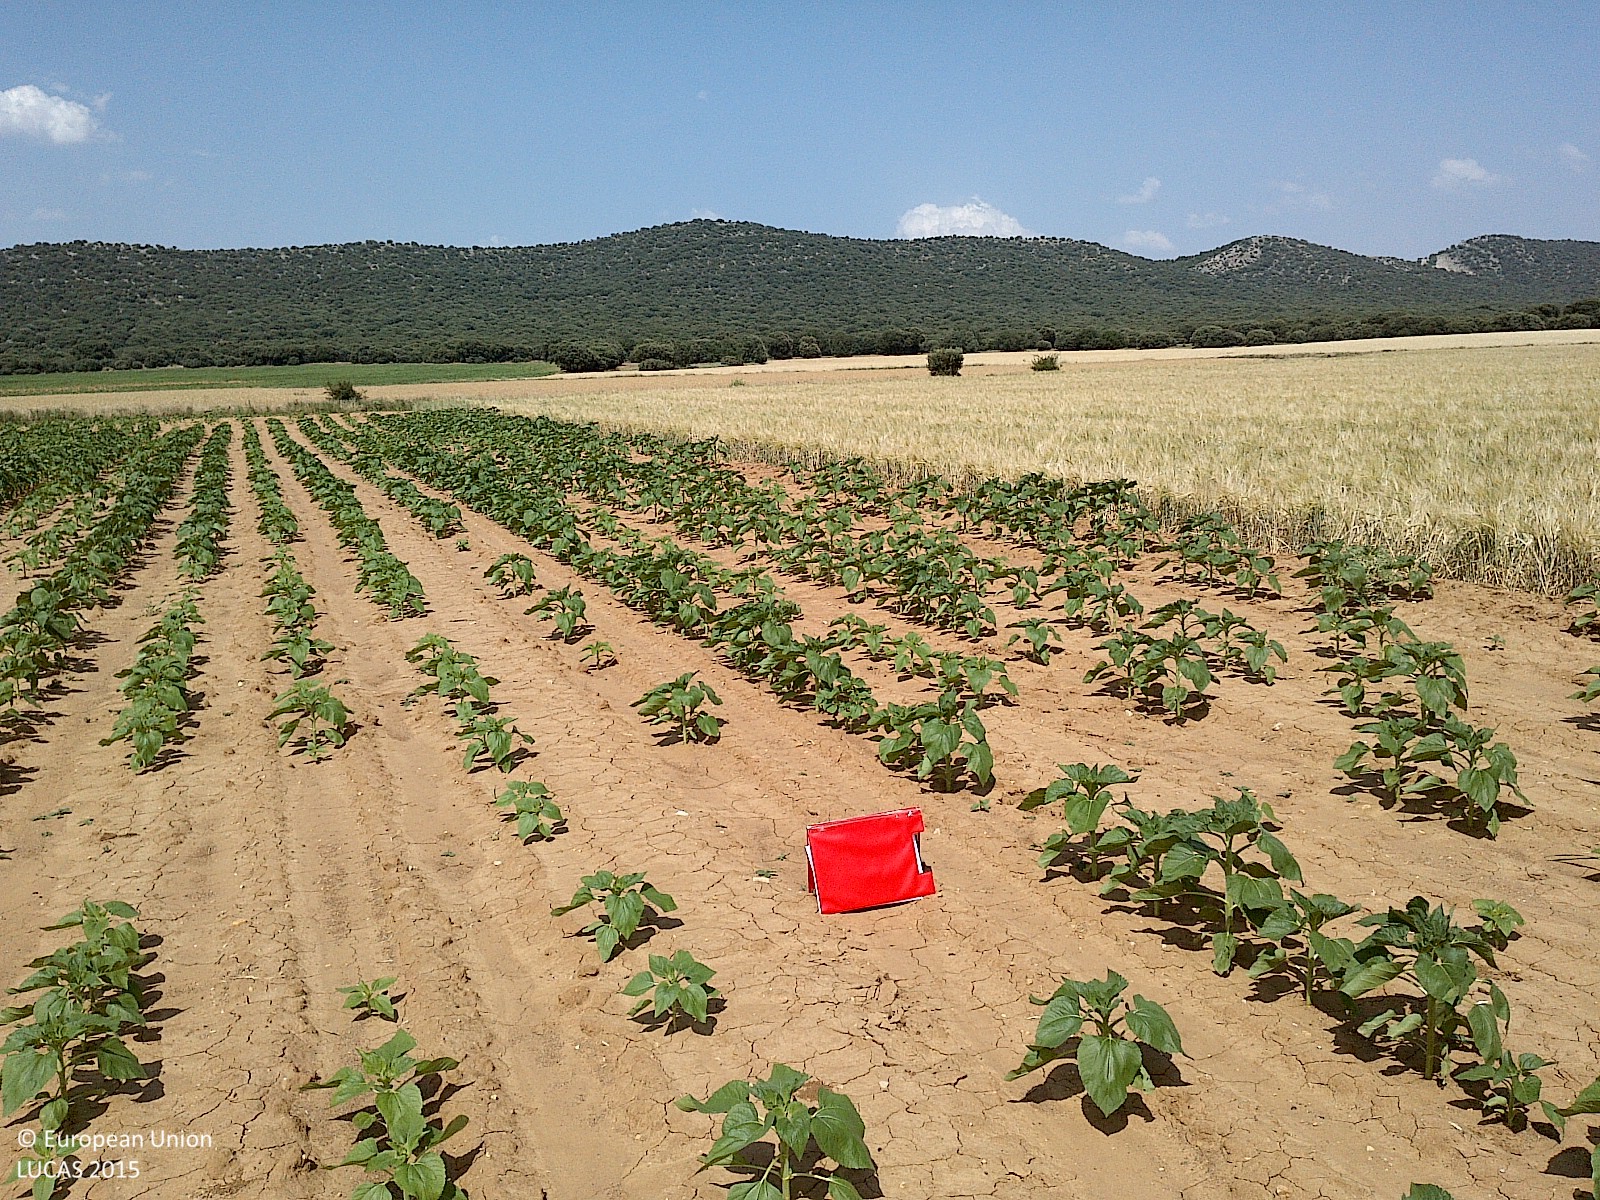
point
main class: Cropland
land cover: Sunflower
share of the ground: < 10 %
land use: Agriculture (excluding fallow land and kitchen gardens)
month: July
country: ES
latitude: 41.6135
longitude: -2.1170
